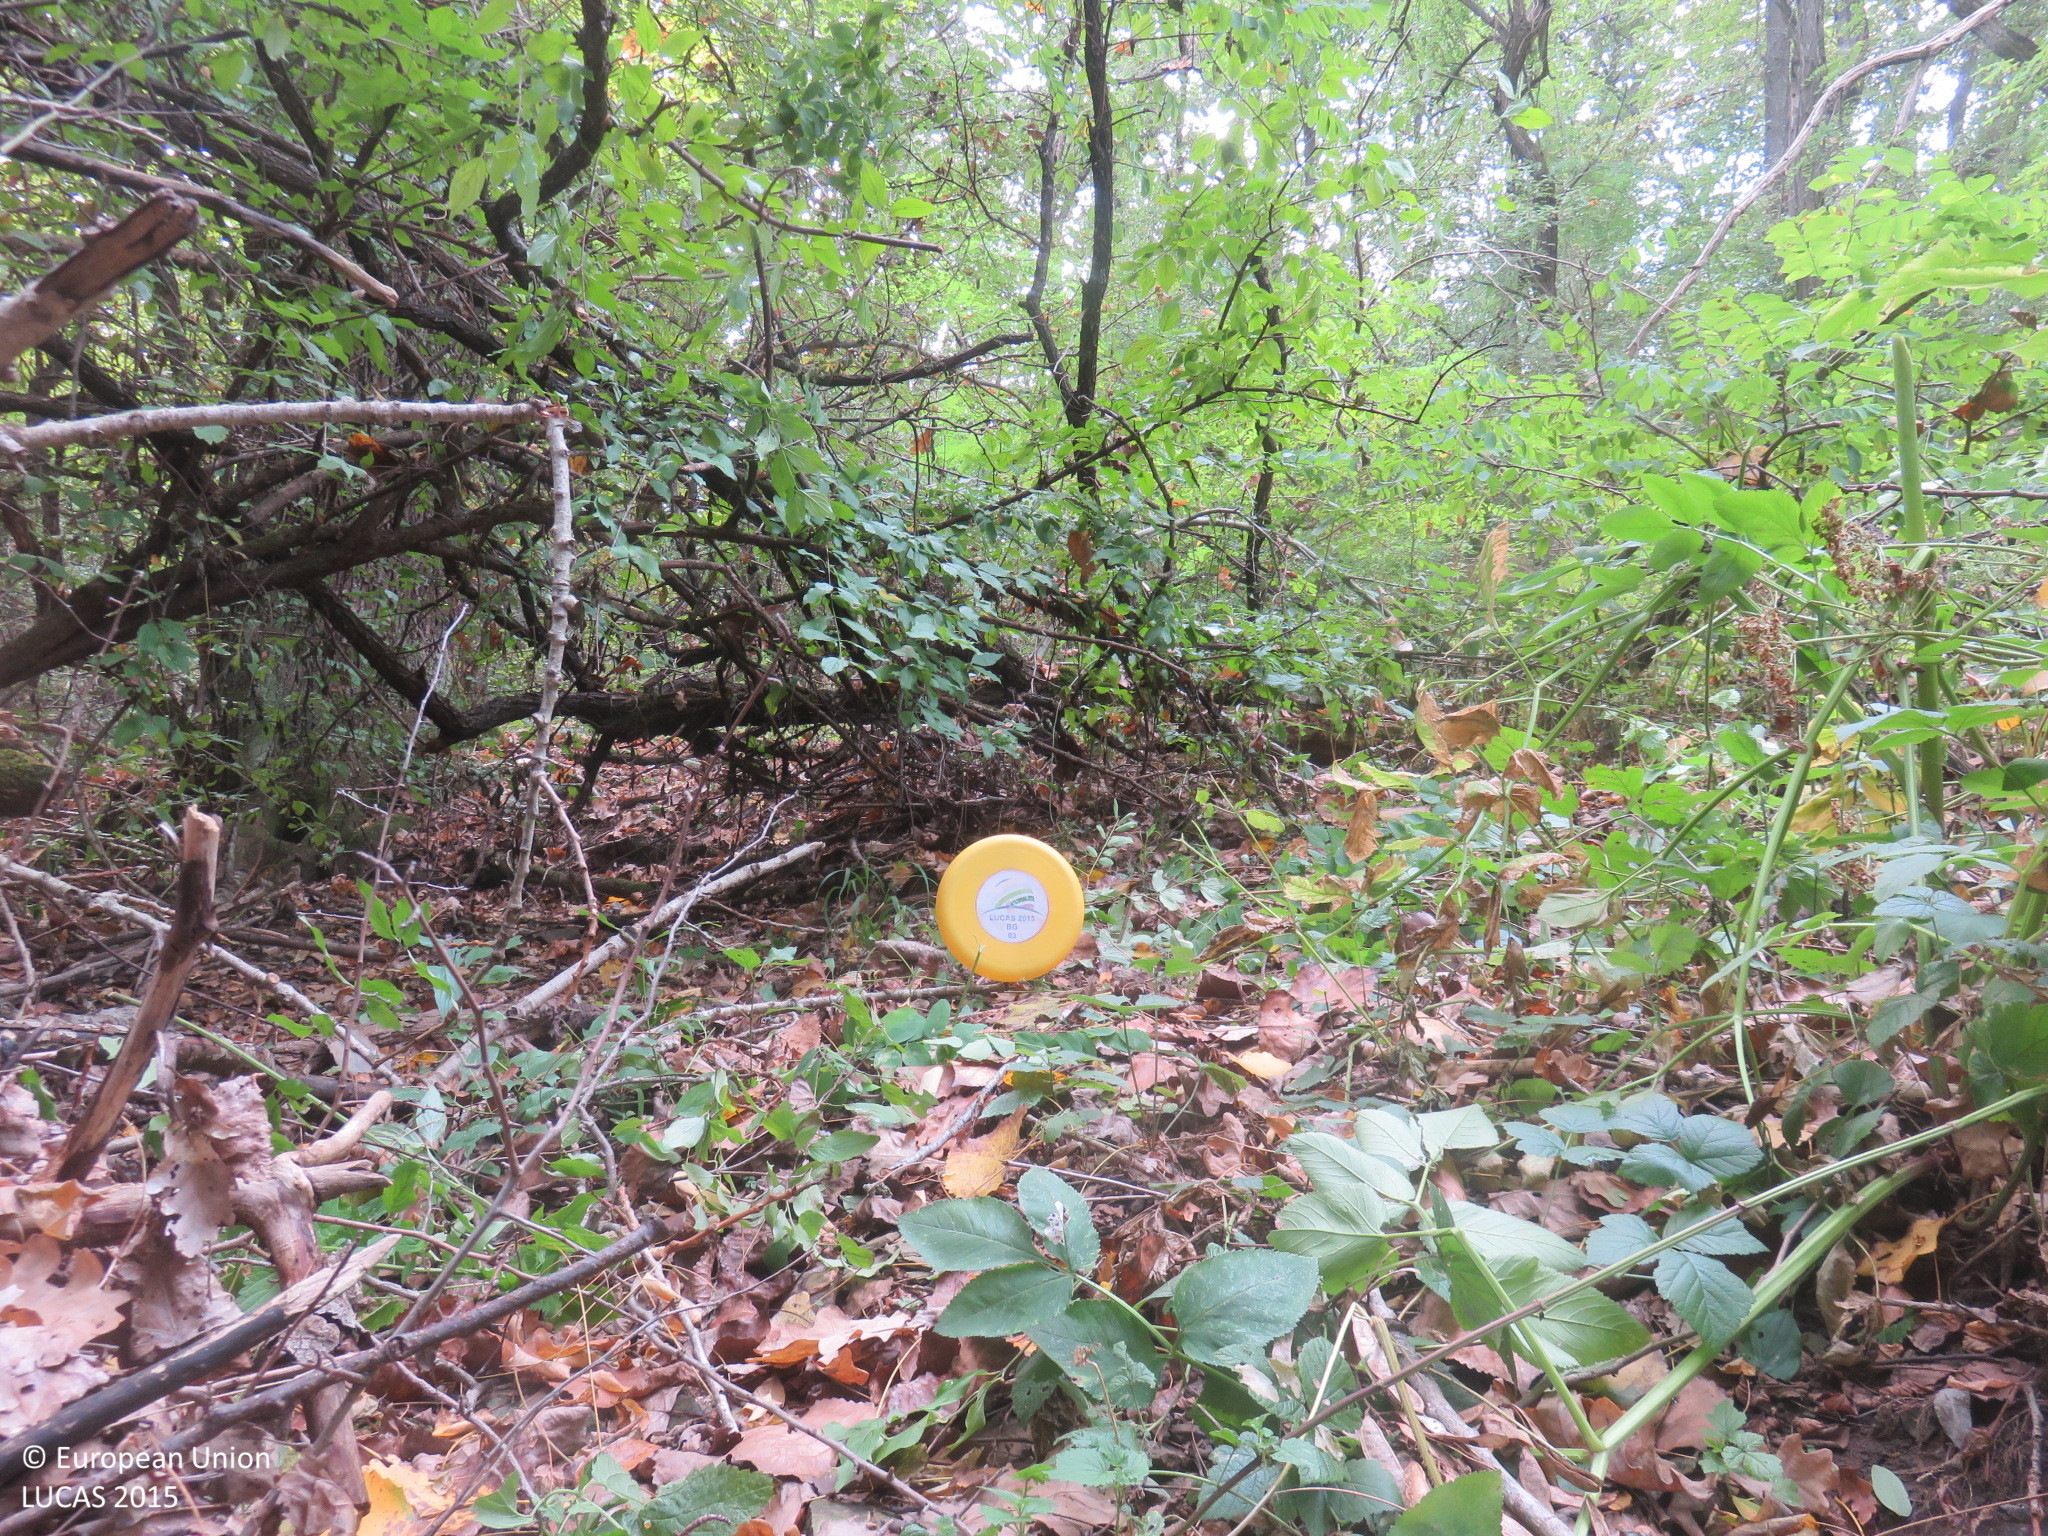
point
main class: Woodland
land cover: Broadleaved woodland
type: mesophytic deciduous forest
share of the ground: > 75 %
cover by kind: broadleaved forest trees 90 %, shrubs 5 %, herbaceous plants 5 %
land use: Forestry
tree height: < 5 m
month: September
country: BG
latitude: 43.0857
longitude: 24.8913
